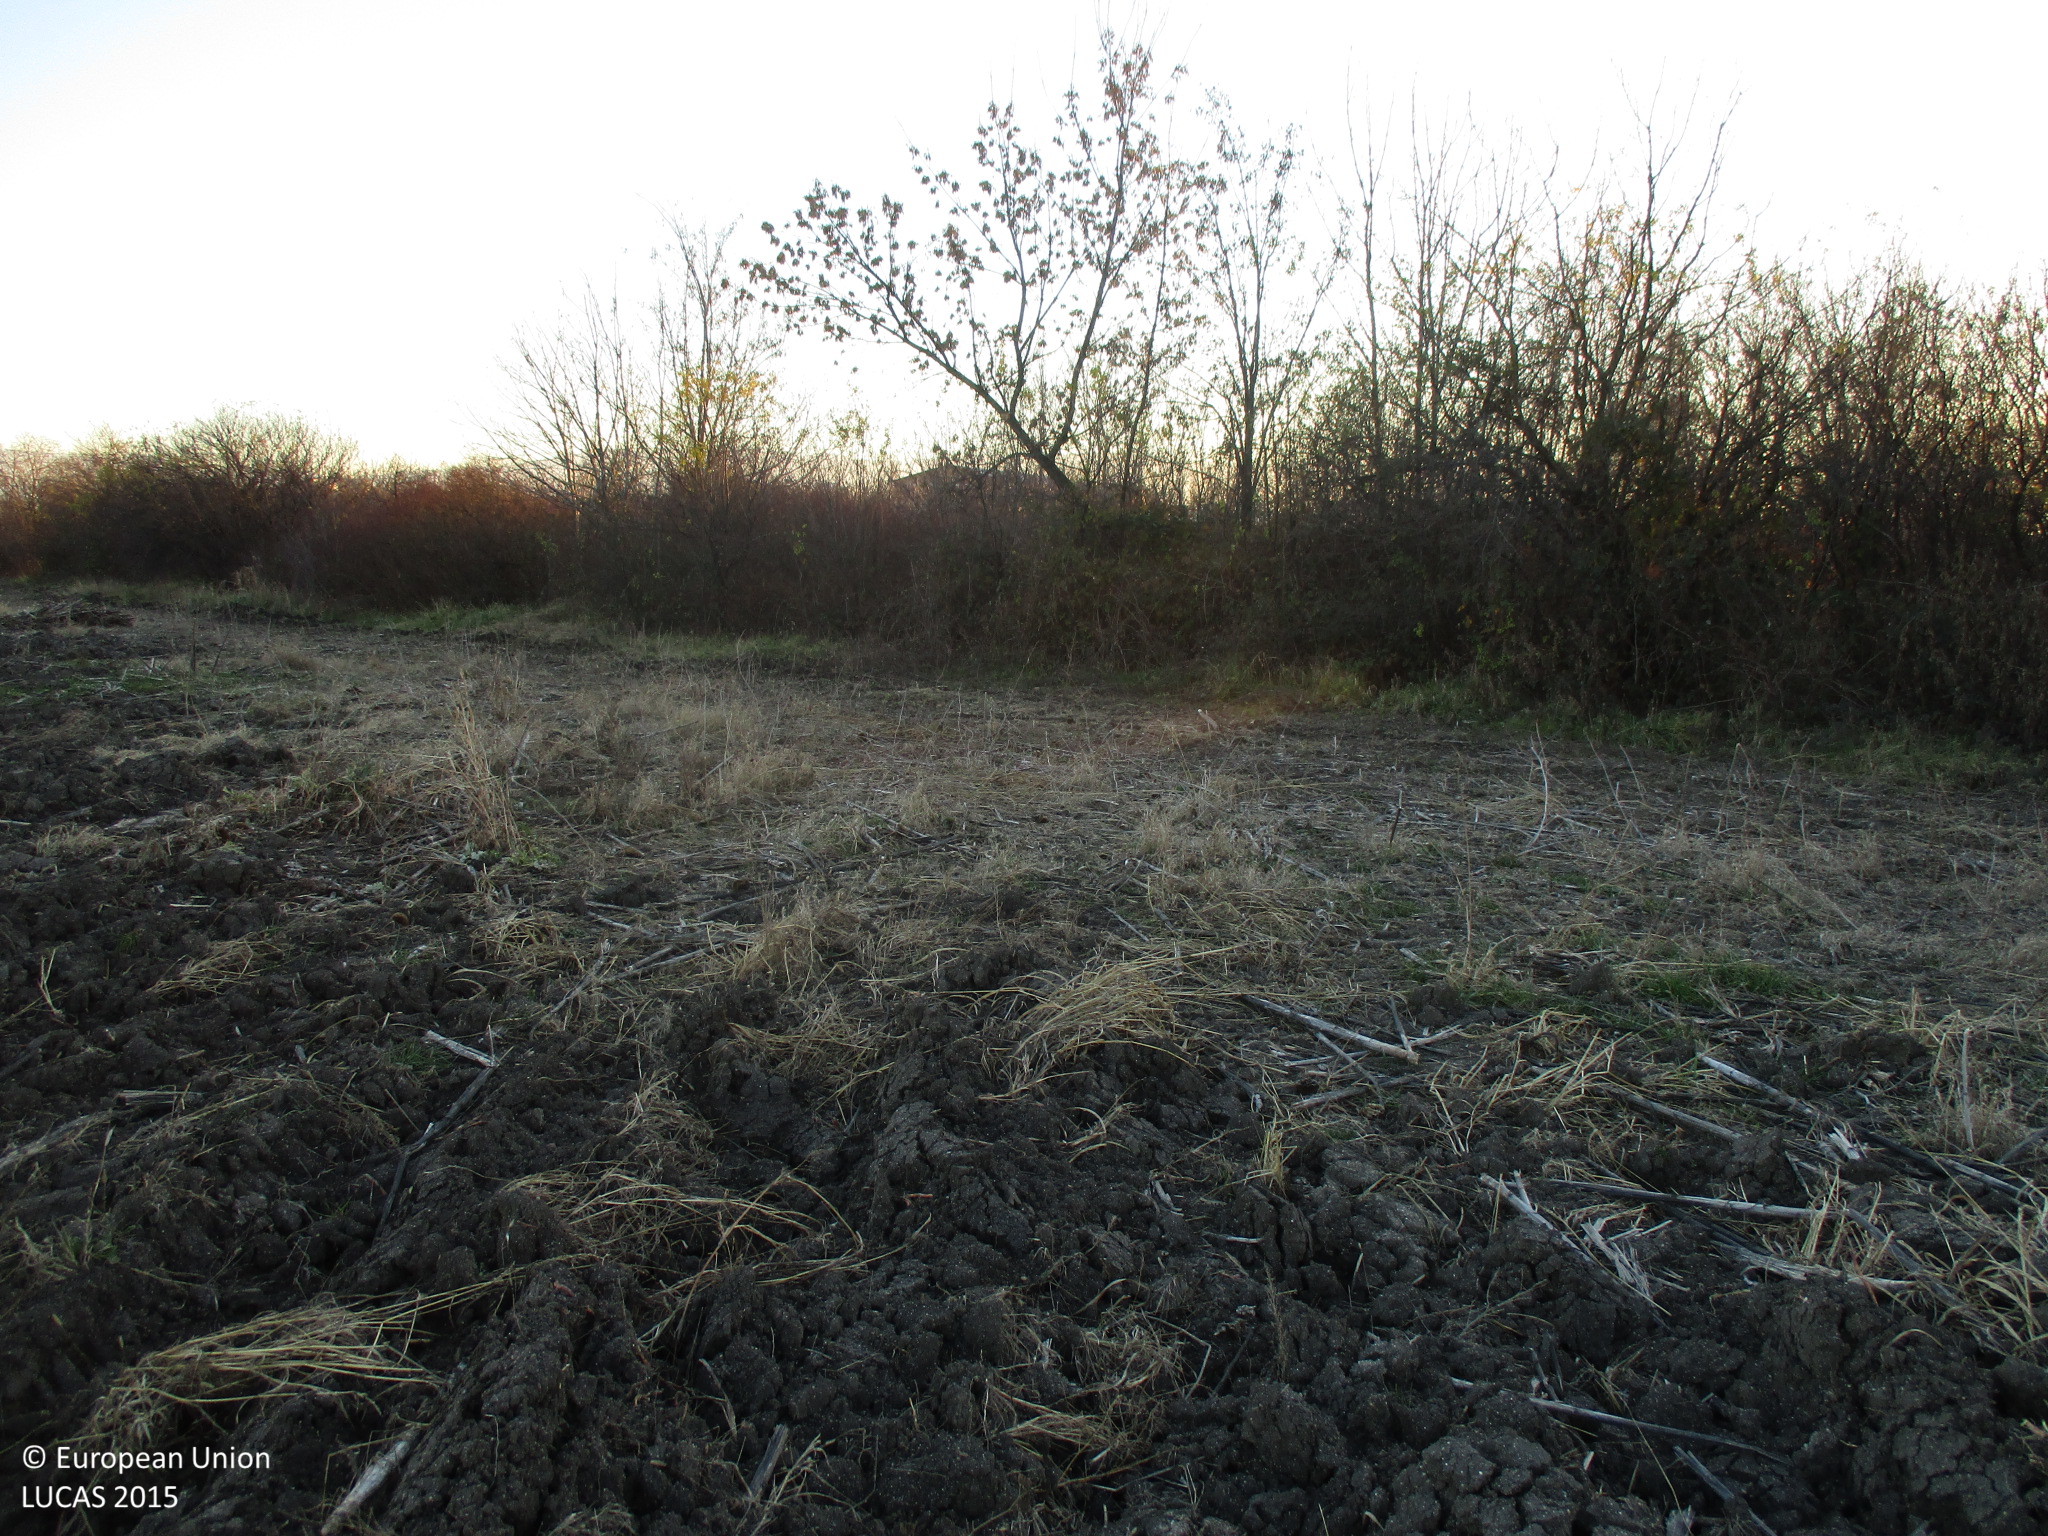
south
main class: Cropland
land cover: Sunflower
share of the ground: < 10 %
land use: Agriculture (excluding fallow land and kitchen gardens)
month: December
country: BG
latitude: 42.1707
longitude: 24.7598
